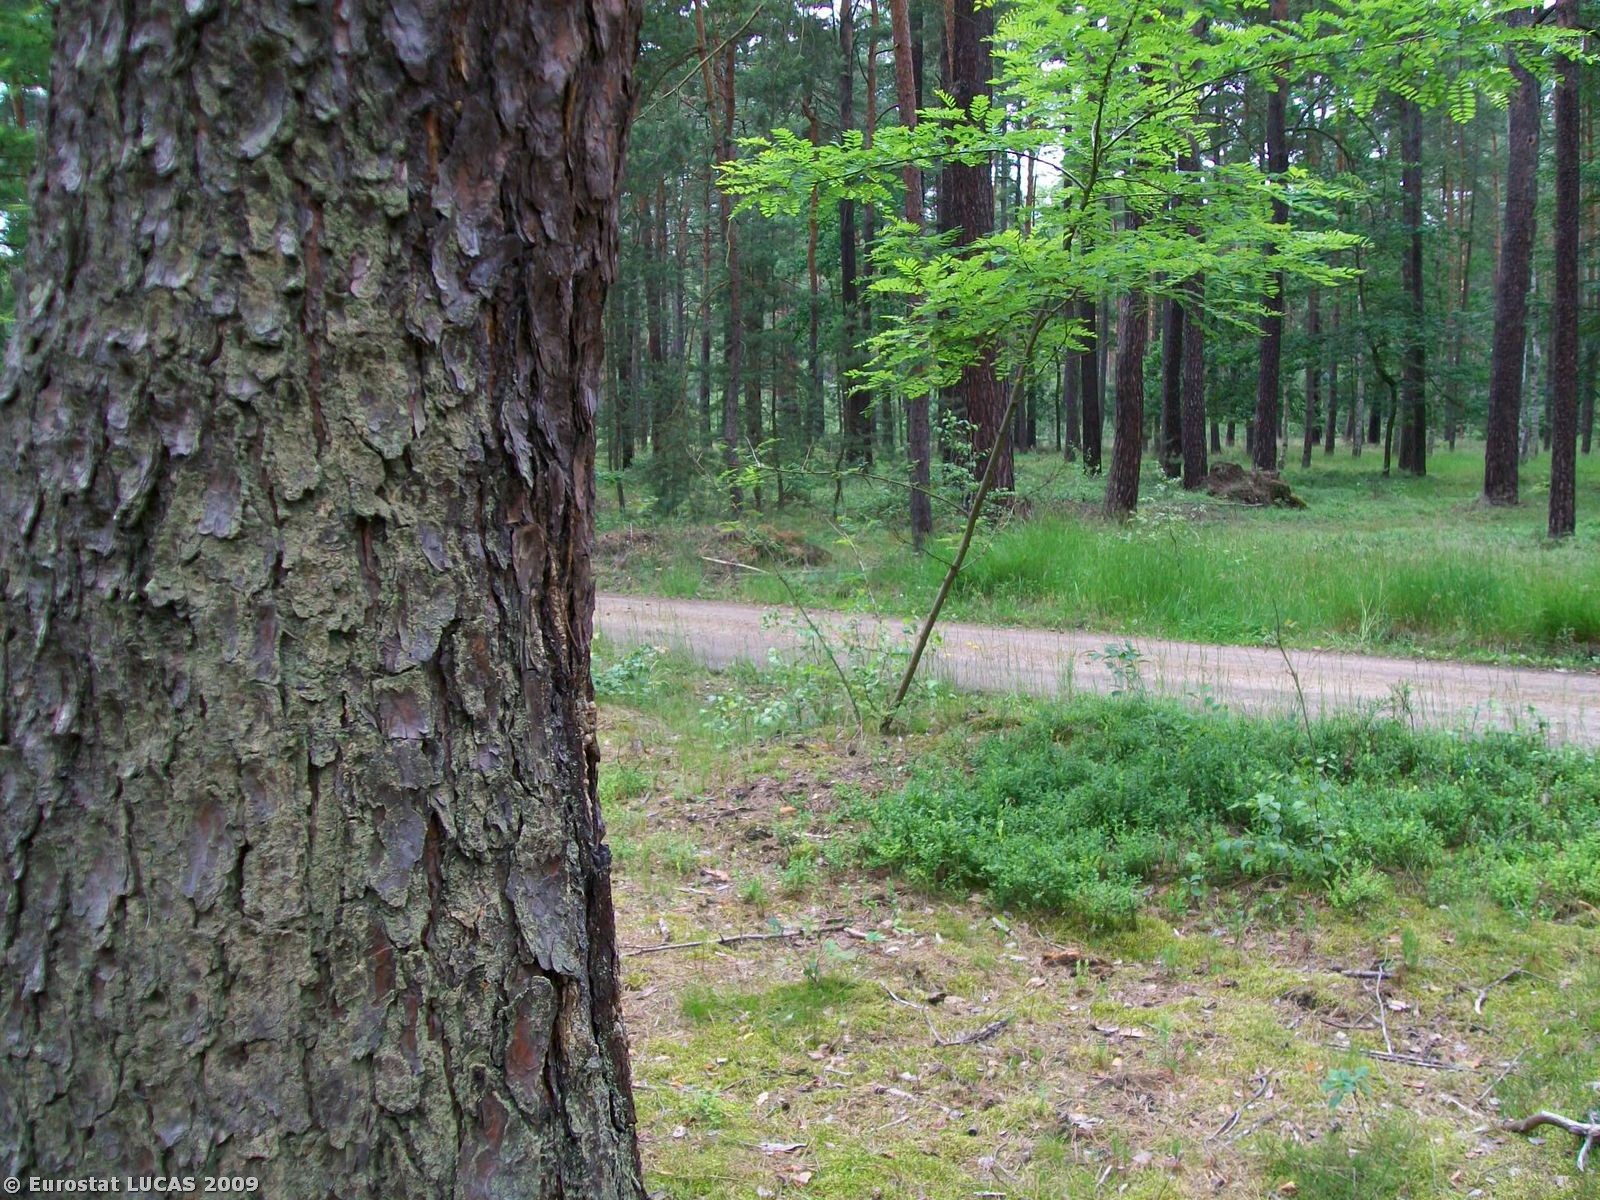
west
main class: Woodland
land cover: Mixed woodland
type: hemiboreal forest and nemoral coniferous forest and mixed broadleaved-coniferous forest
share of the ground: > 75 %
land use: Forestry
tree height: > 5 m
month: June
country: PL
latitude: 51.4530
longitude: 15.1984
